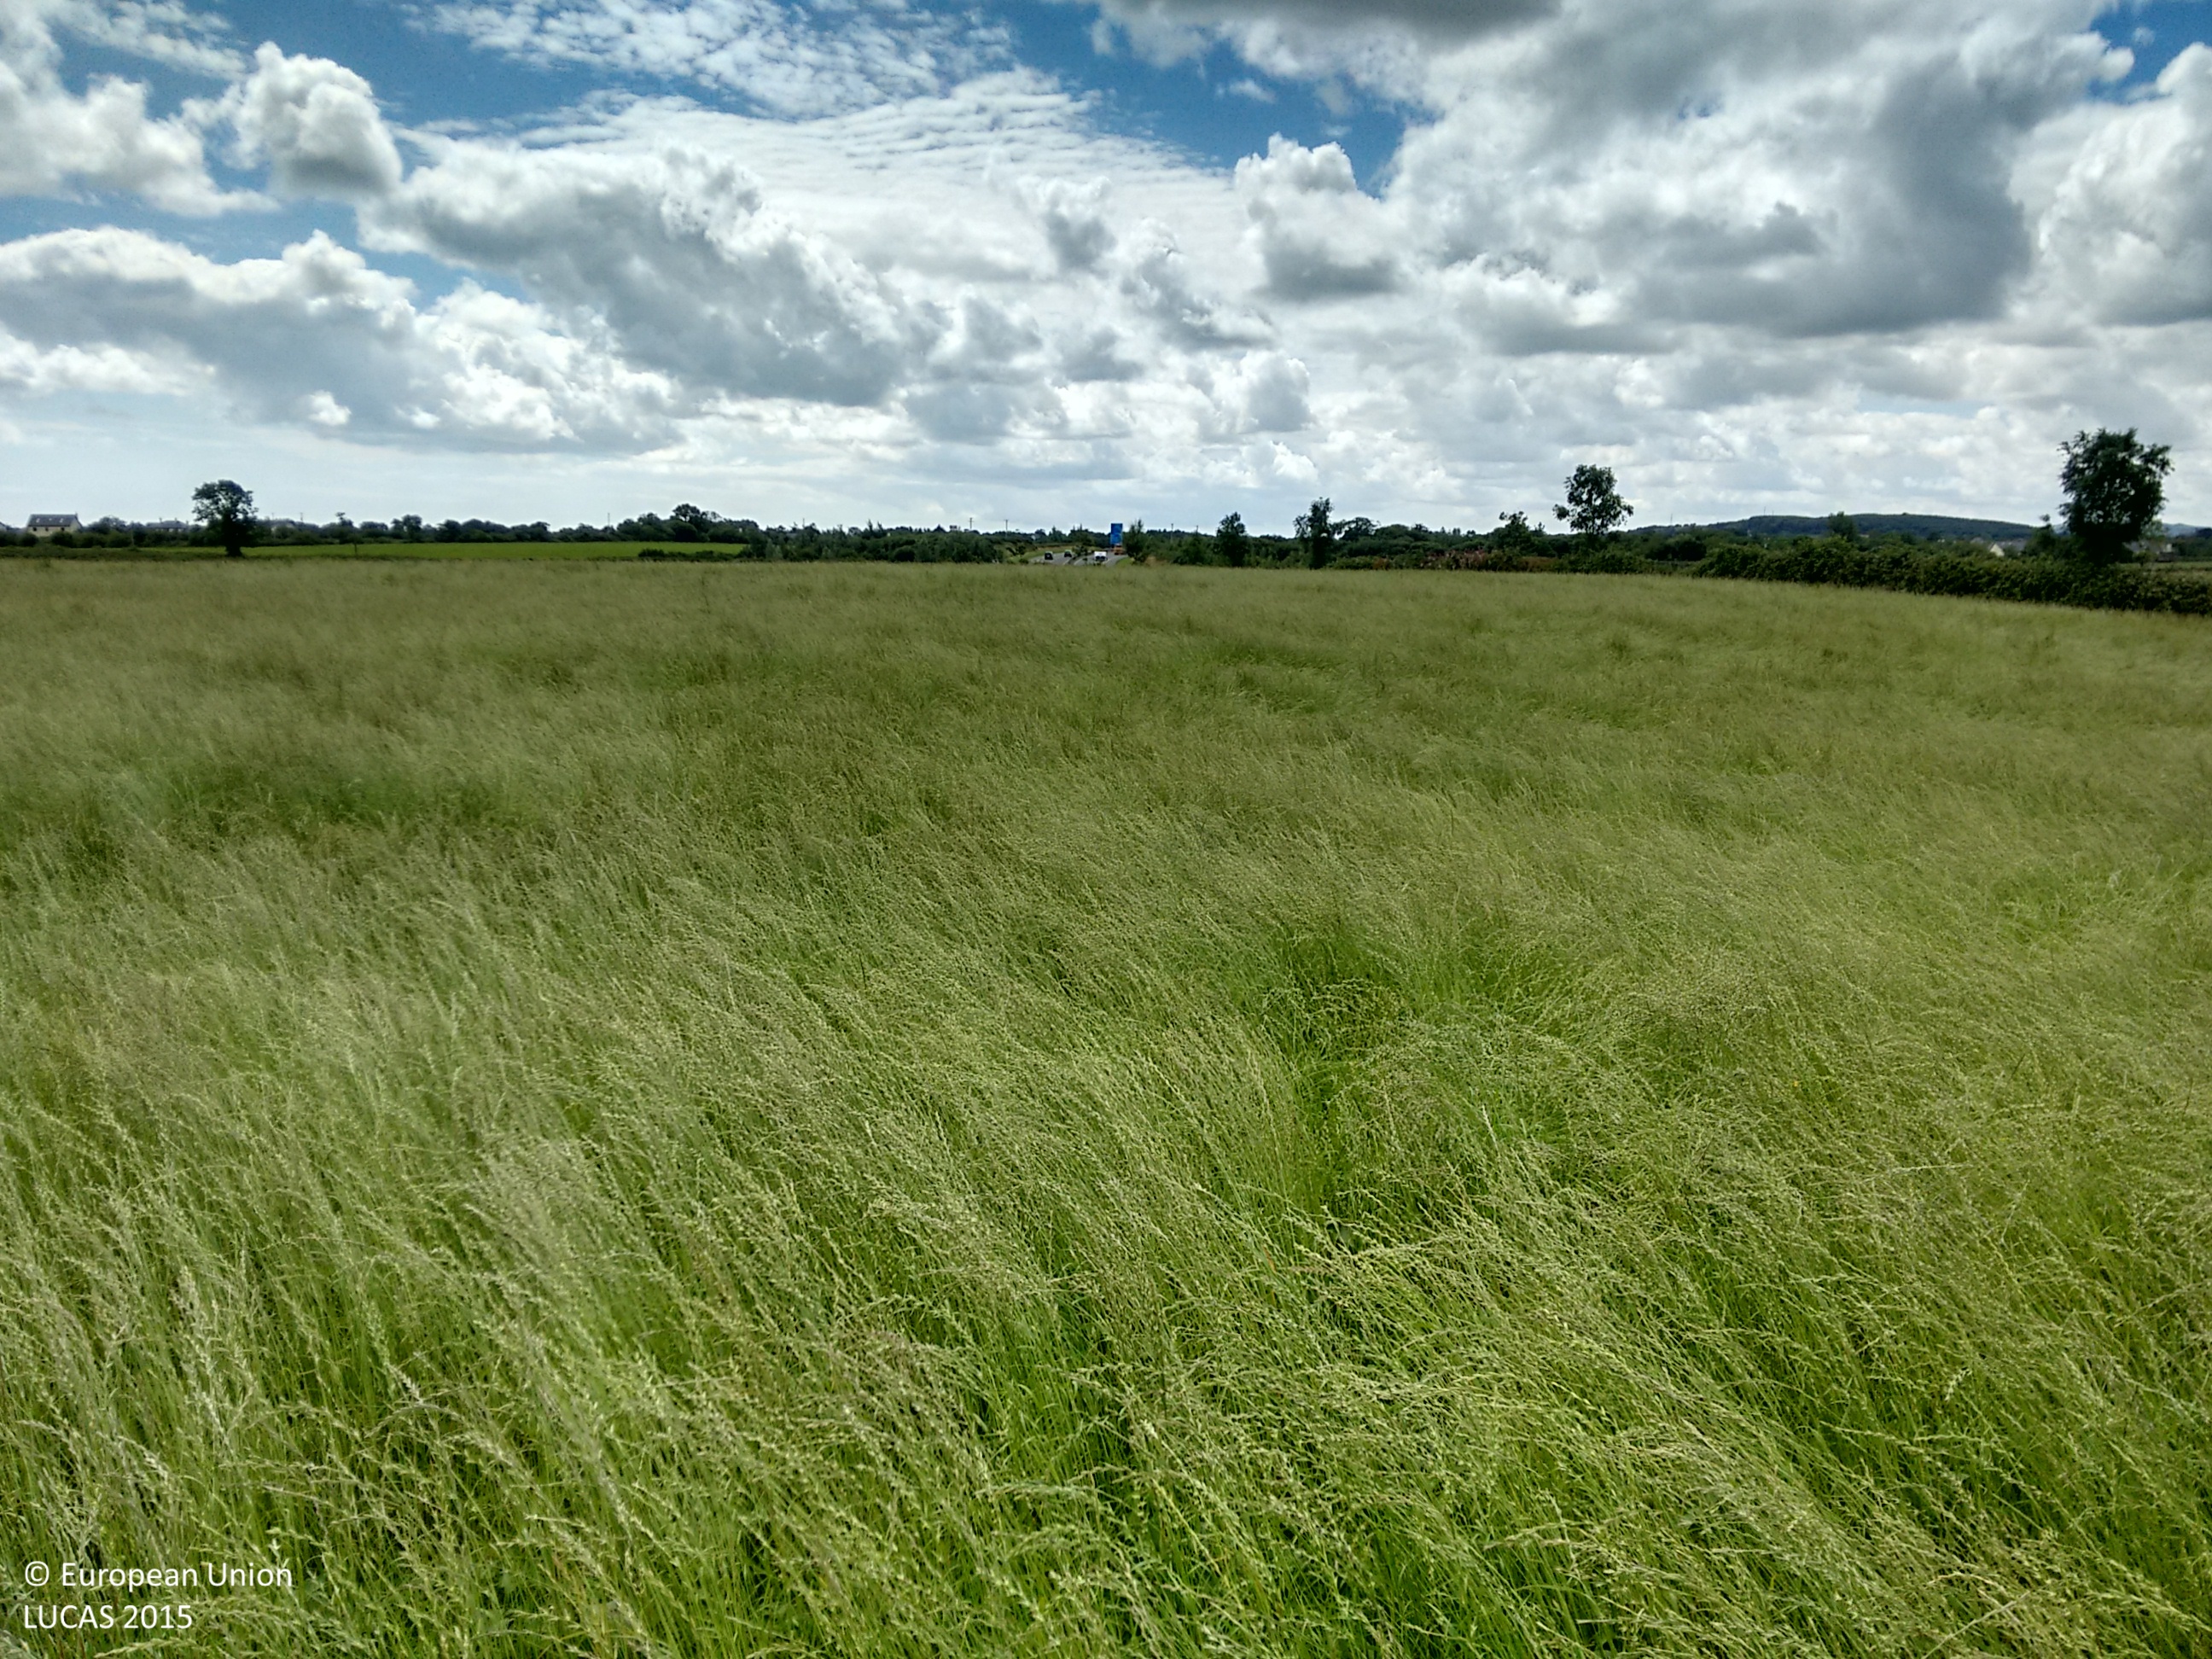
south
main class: Grassland
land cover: Grassland without tree/shrub cover
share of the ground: > 75 %
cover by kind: herbaceous plants 100 %
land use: Agriculture (excluding fallow land and kitchen gardens)
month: August
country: IE
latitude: 52.6781
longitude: -6.2573
